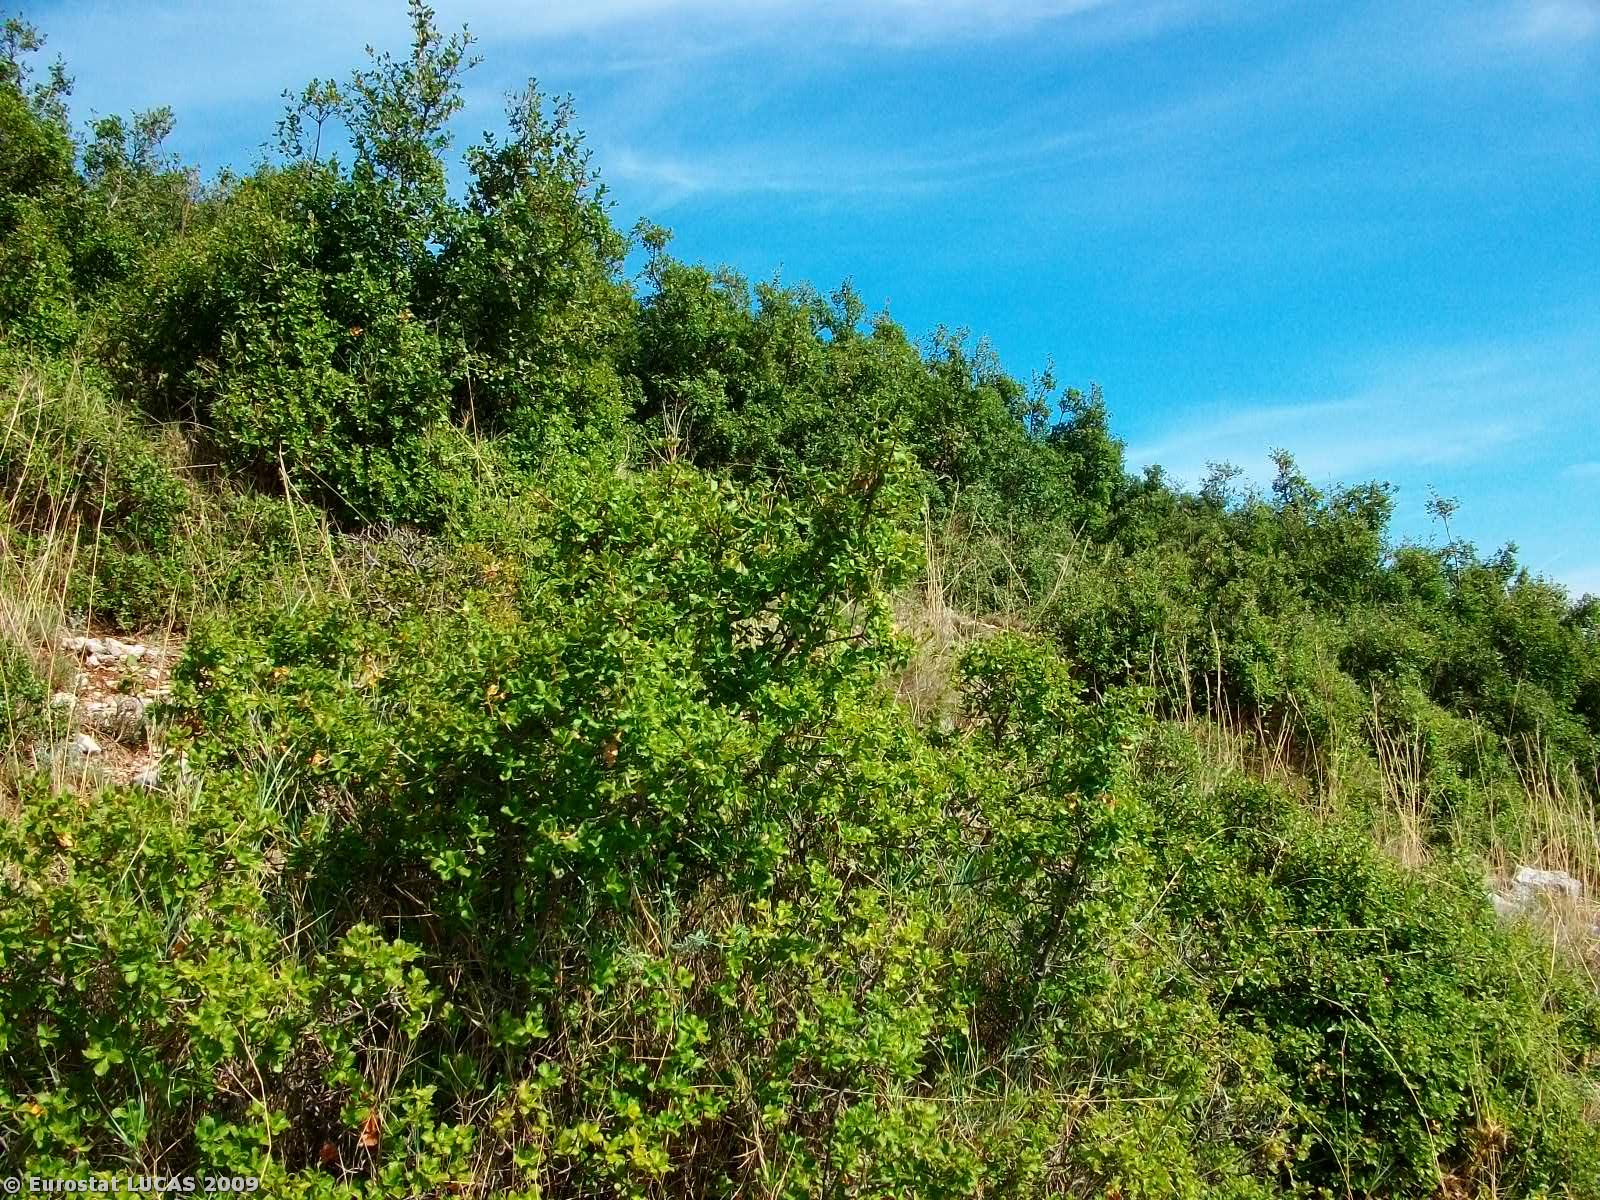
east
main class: Shrubland
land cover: Shrubland without tree cover
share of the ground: 50 - 75 %
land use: Agriculture (excluding fallow land and kitchen gardens)
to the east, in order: Shrubland without tree cover; Grassland with sparse tree/shrub cover; Shrubland without tree cover; Electric lines; Shrubland without tree cover; Bare land; Shrubland without tree cover; Paved roads, cycling and walking lanes
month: September
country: GR
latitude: 39.6185
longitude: 20.2608
